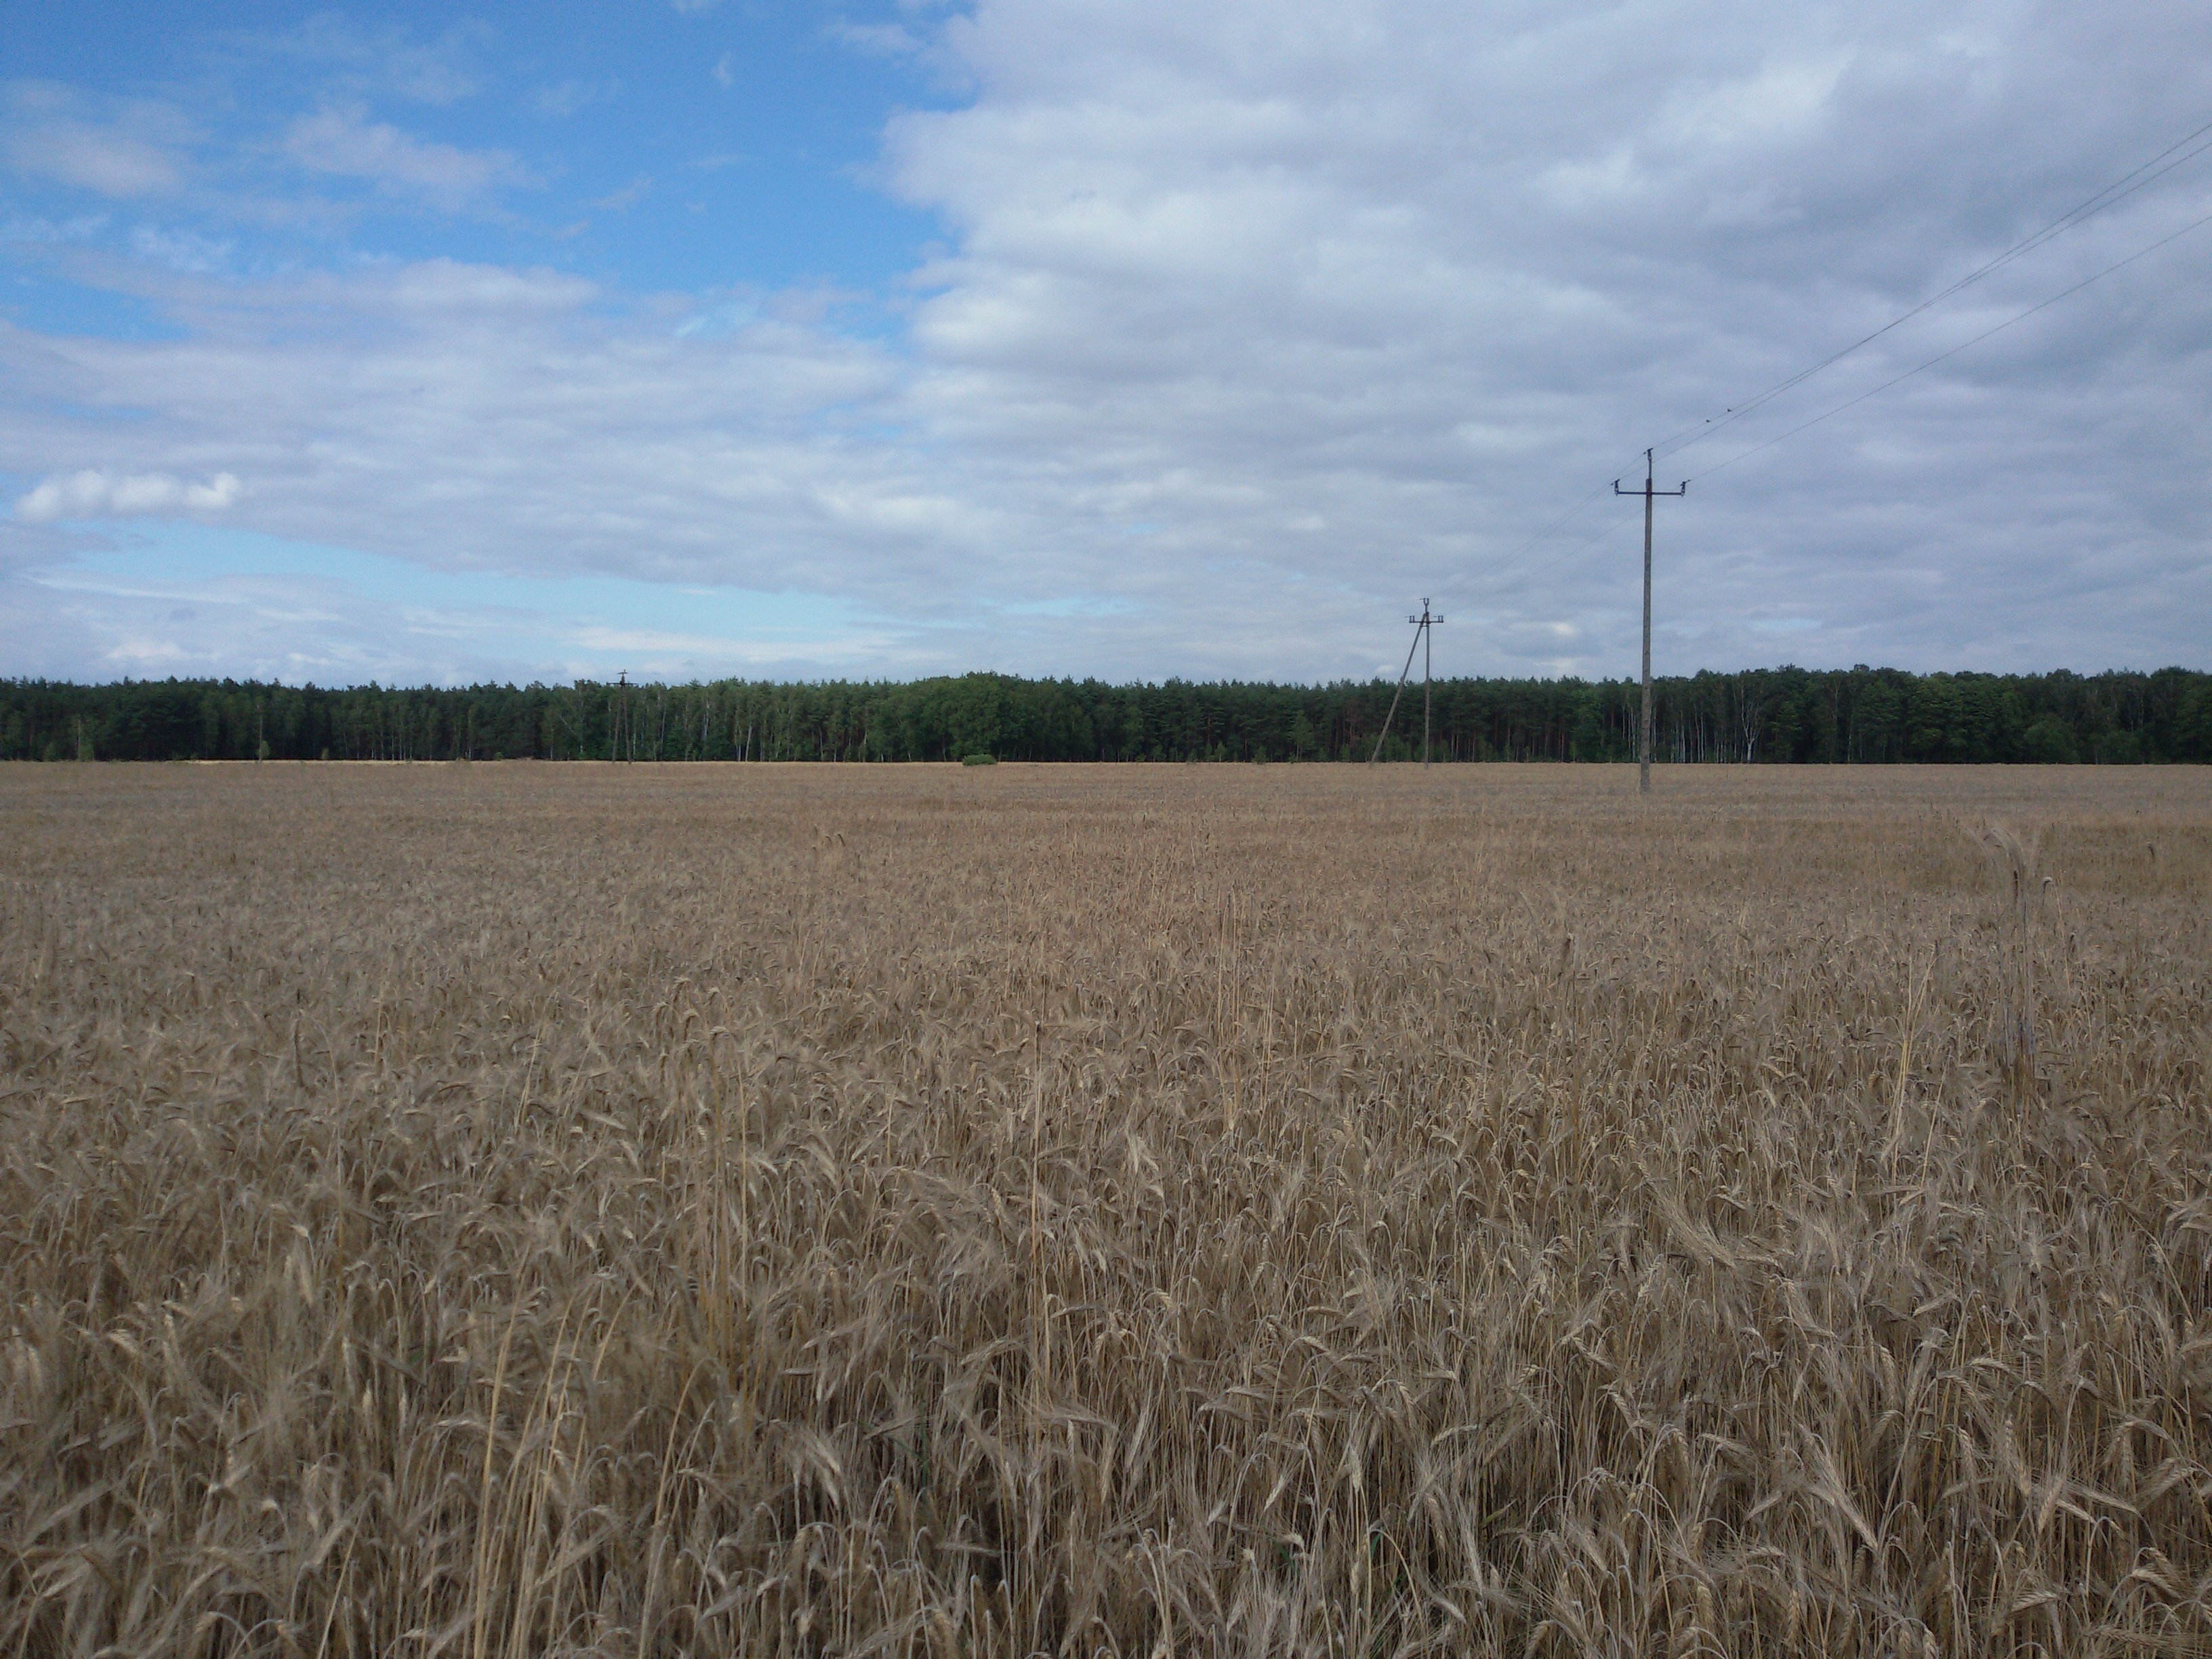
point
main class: Cropland
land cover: Triticale
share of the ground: > 75 %
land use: Agriculture (excluding fallow land and kitchen gardens)
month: July
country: PL
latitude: 52.8384
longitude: 17.0017
